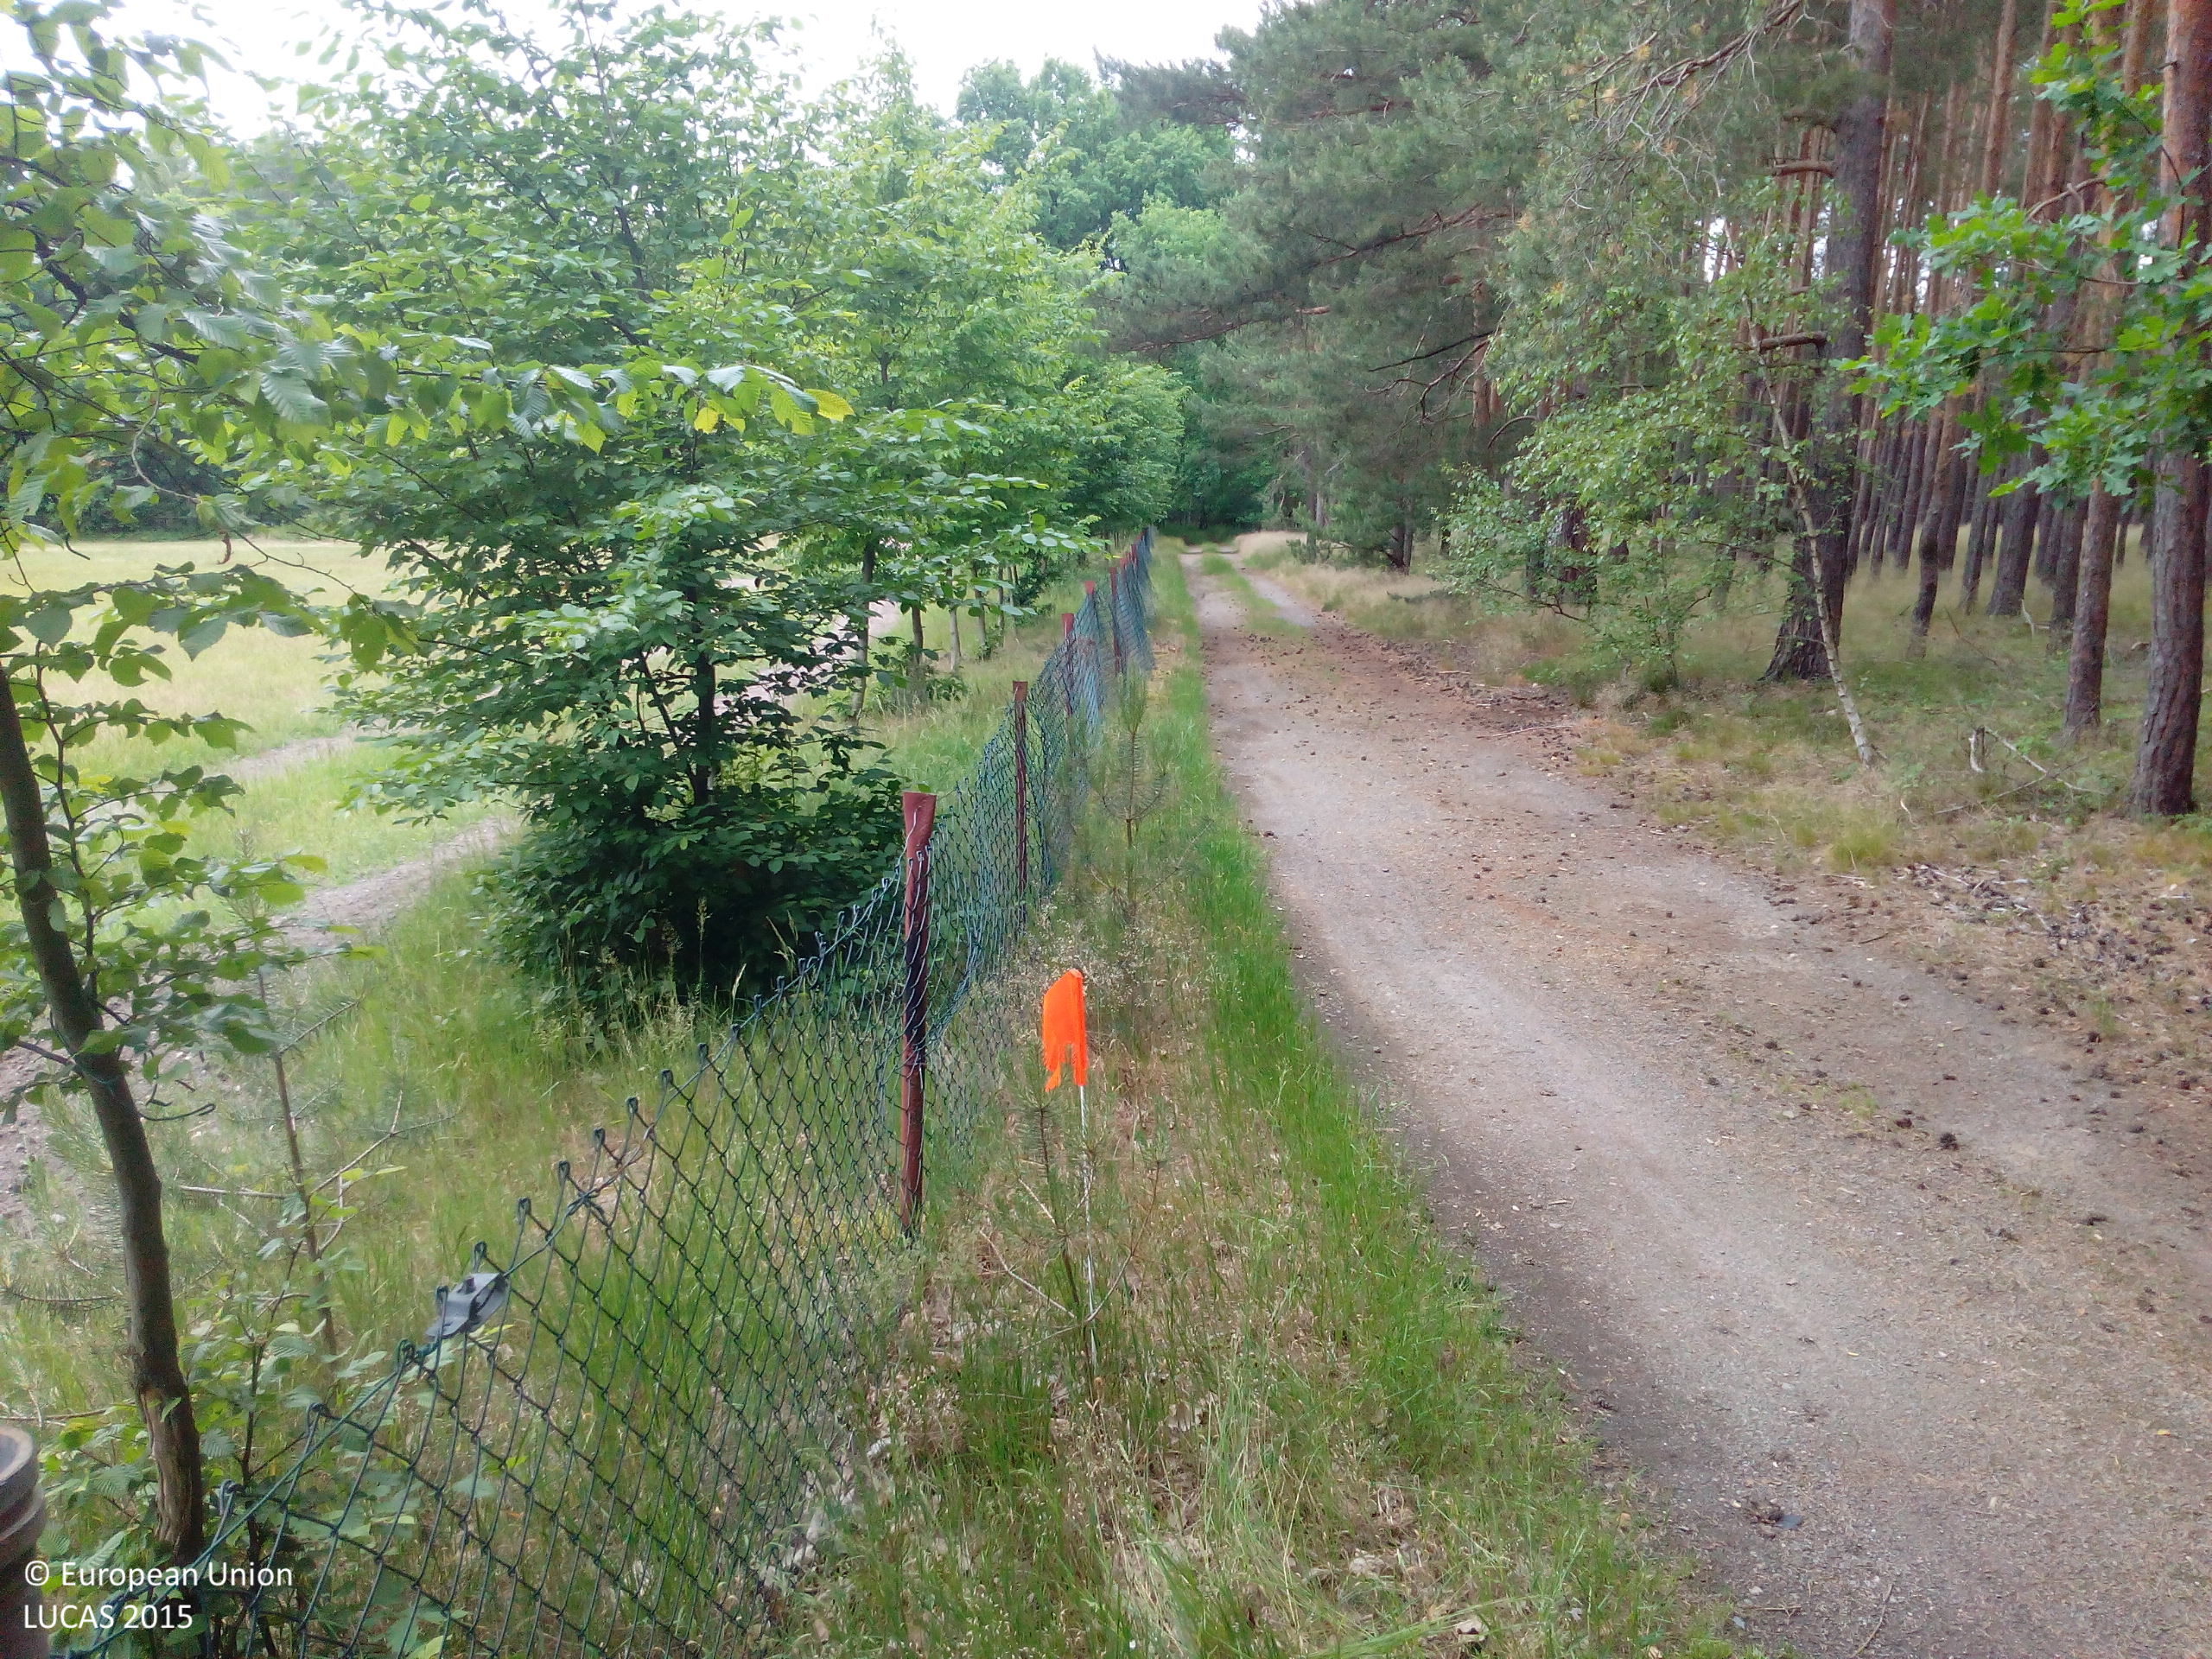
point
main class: Woodland
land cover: Pine dominated mixed woodland
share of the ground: > 75 %
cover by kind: coniferous forest trees 65 %, broadleaved forest trees 25 %, herbaceous plants 10 %
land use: Forestry
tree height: > 5 m
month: June
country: DE
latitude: 51.3560
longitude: 14.0075
